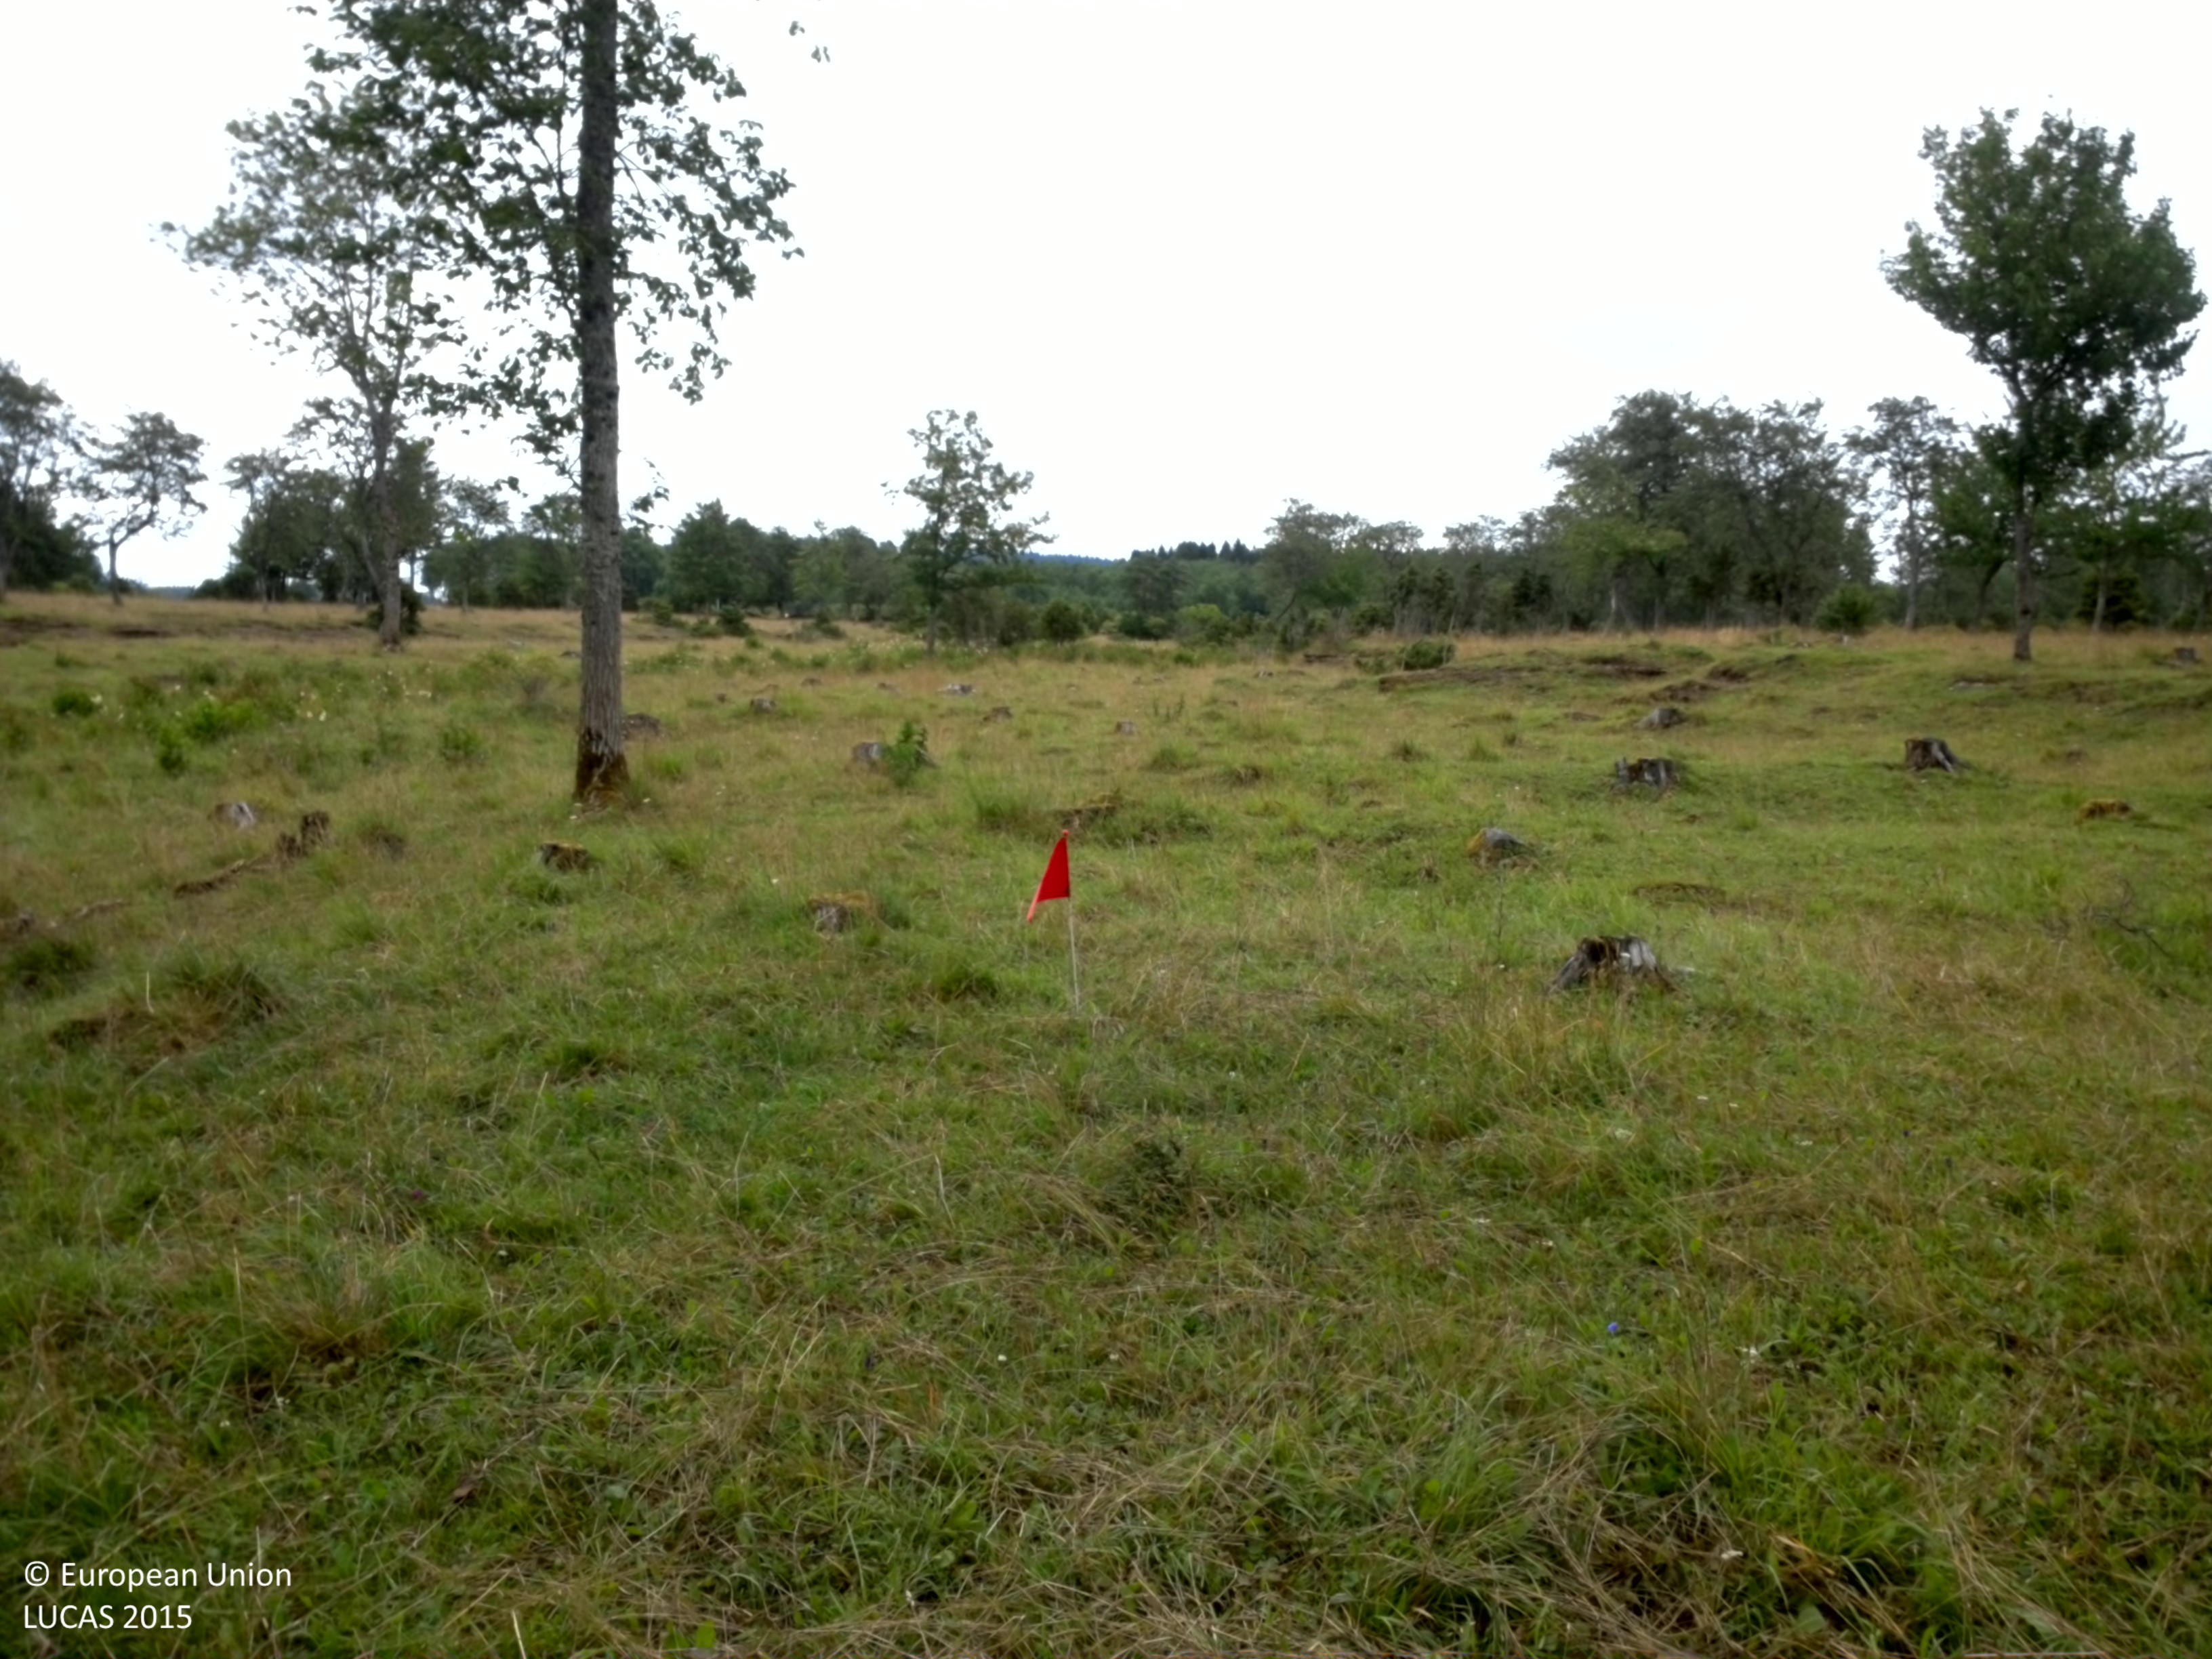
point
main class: Grassland
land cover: Grassland with sparse tree/shrub cover
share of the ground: > 75 %
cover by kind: herbaceous plants 90 %, broadleaved forest trees 5 %, shrubs 5 %
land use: Agriculture (excluding fallow land and kitchen gardens)
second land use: Amenities, museums, leisure
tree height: > 5 m
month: July
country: SE
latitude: 58.5731
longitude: 13.3812
